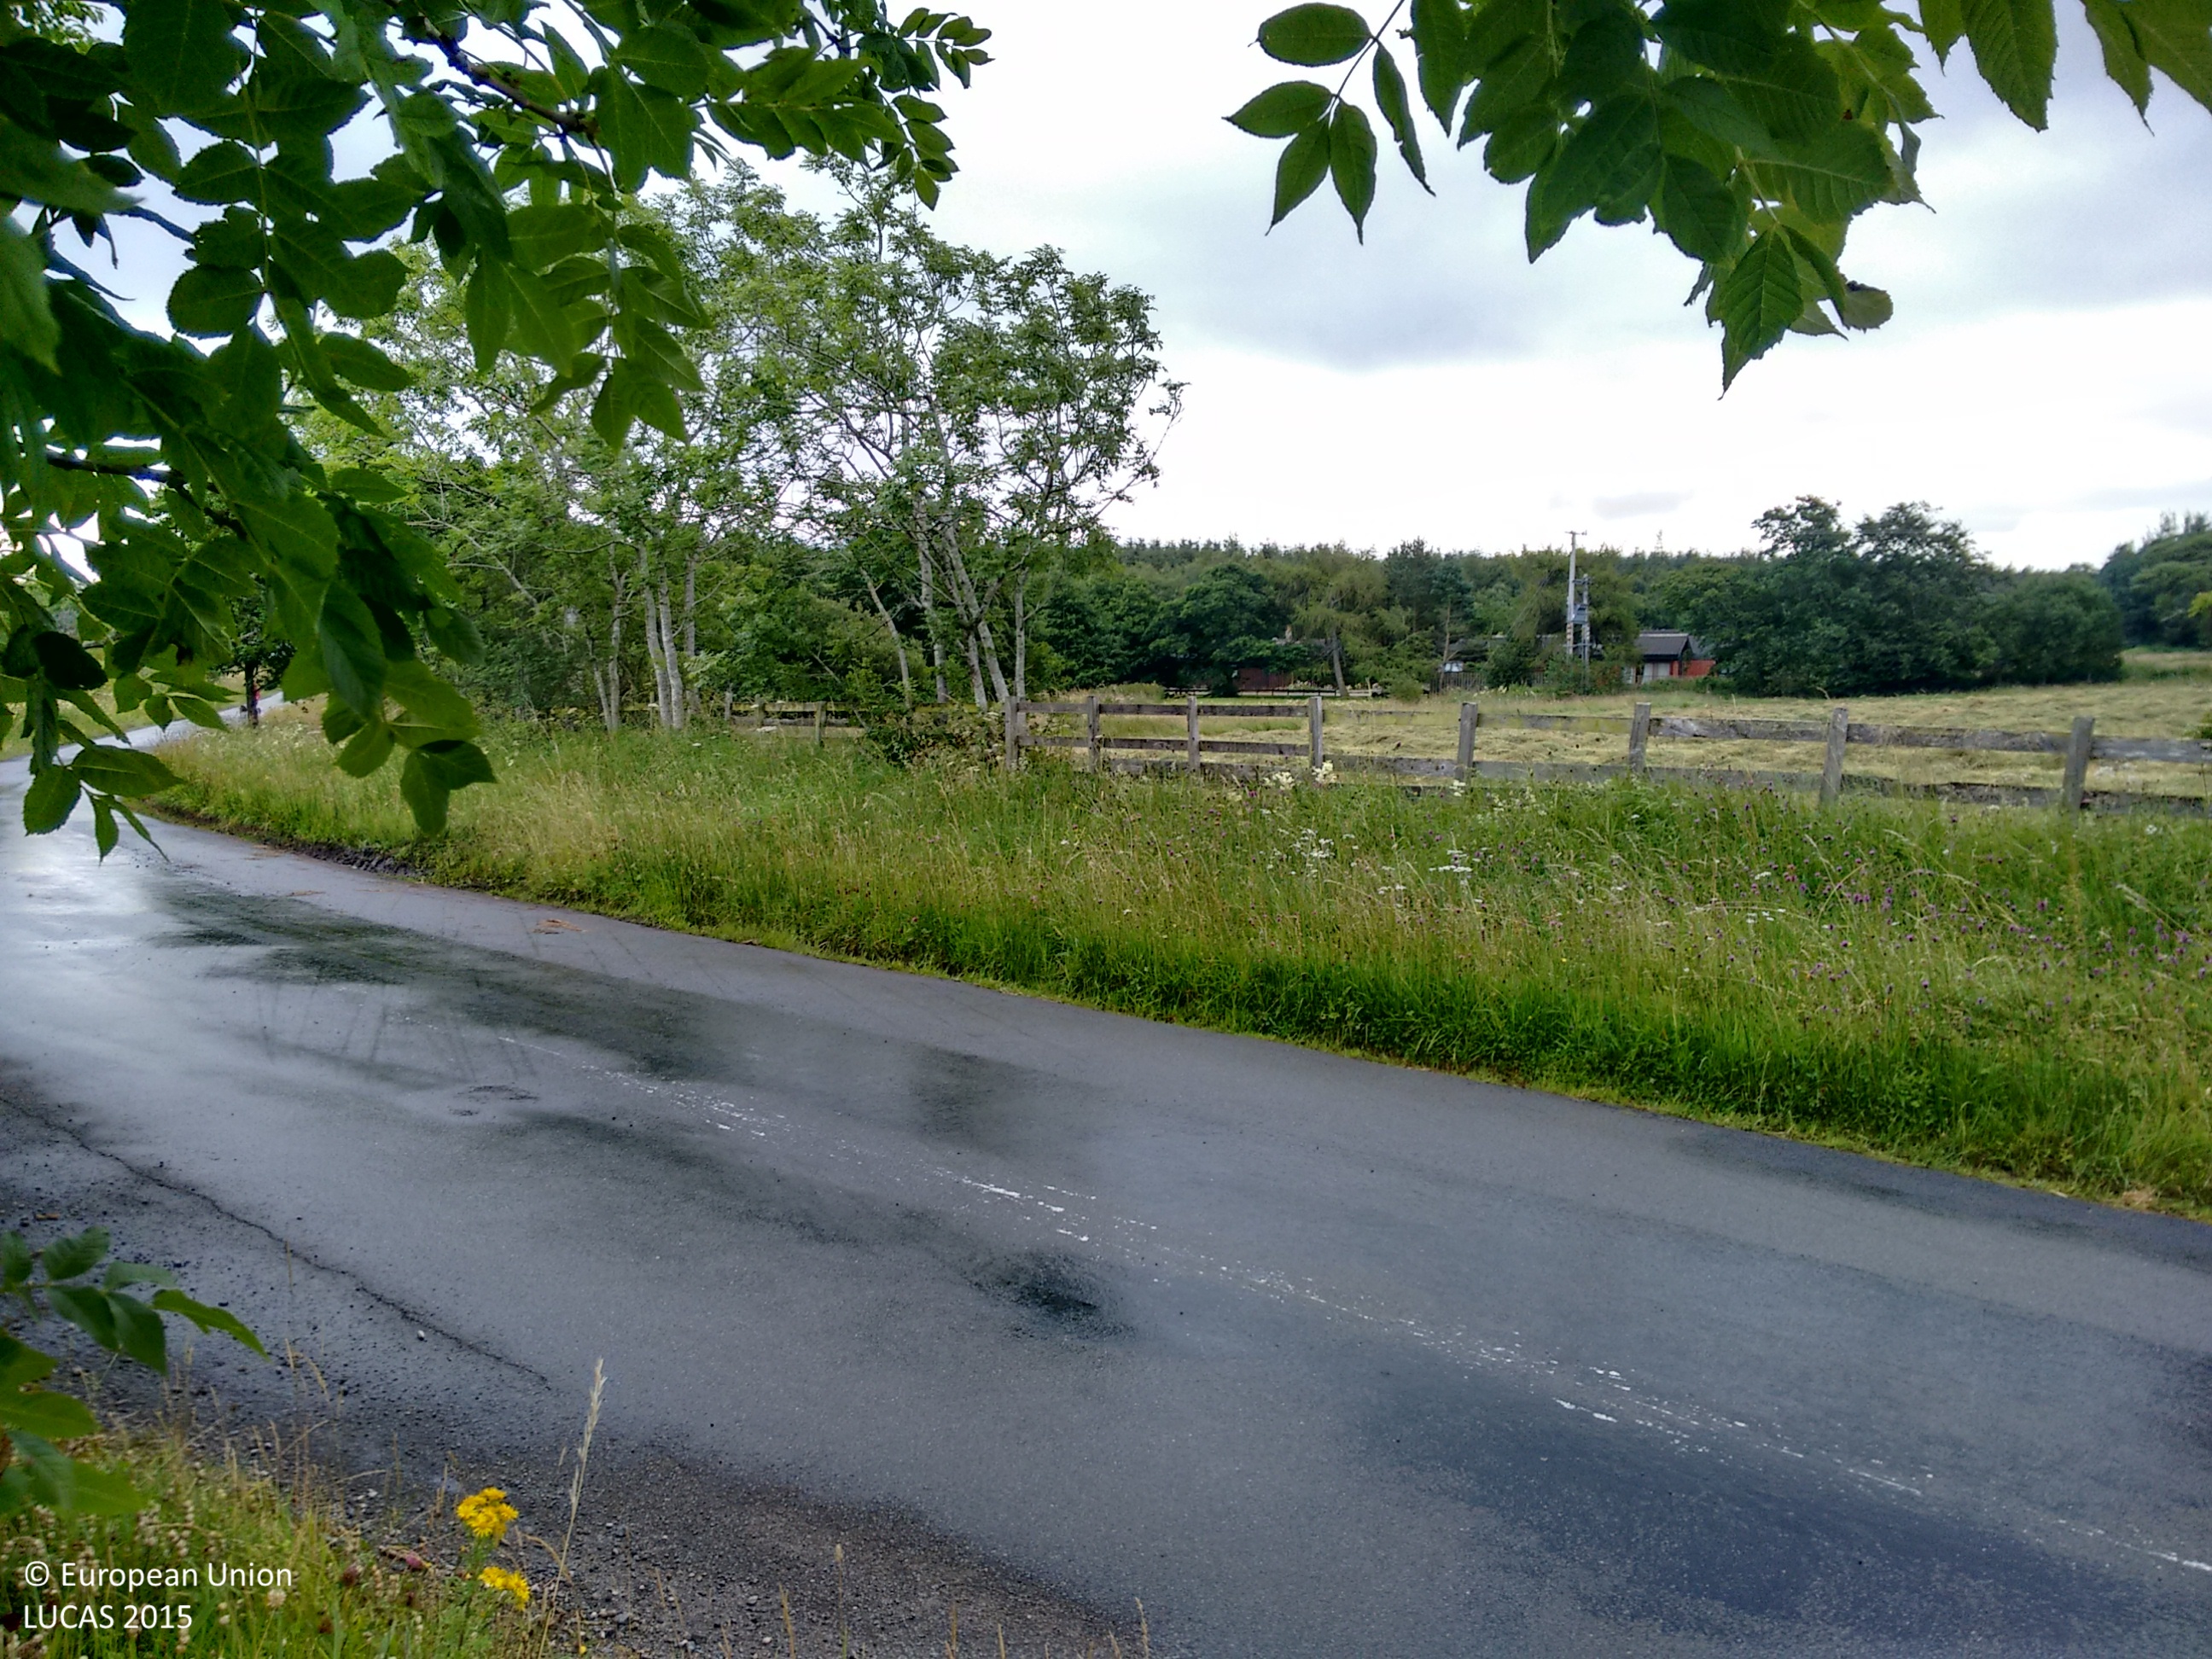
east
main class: Grassland
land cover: Grassland with sparse tree/shrub cover
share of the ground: > 75 %
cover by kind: herbaceous plants 95 %, broadleaved forest trees 5 %
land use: Agriculture (excluding fallow land and kitchen gardens)
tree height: > 5 m
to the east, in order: Grassland with sparse tree/shrub cover; Grassland without tree/shrub cover; Fences; Dry stone walls; Grassland with sparse tree/shrub cover; Paved roads, cycling and walking lanes; Grassland with sparse tree/shrub cover; Dry stone walls; Fences; Grassland without tree/shrub cover
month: August
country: GB
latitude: 54.7088
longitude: -2.9375
